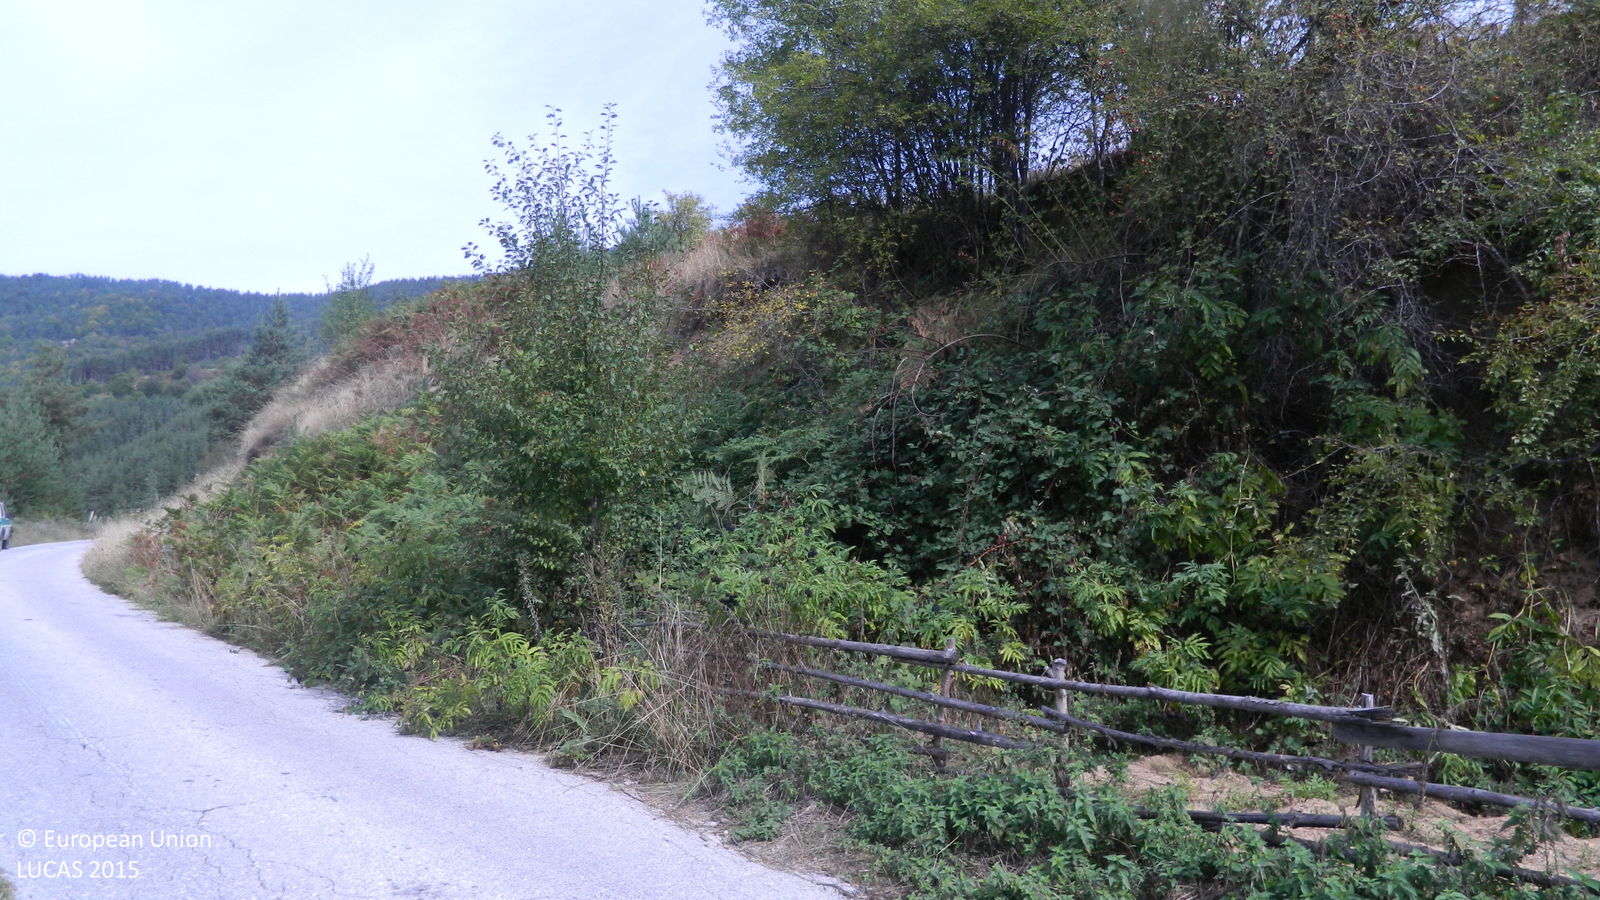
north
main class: Woodland
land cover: Pine dominated mixed woodland
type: hemiboreal forest and nemoral coniferous forest and mixed broadleaved-coniferous forest
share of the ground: > 75 %
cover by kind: coniferous forest trees 75 %, broadleaved forest trees 25 %
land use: Forestry
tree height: > 5 m
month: October
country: BG
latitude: 41.5838
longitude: 24.8848
